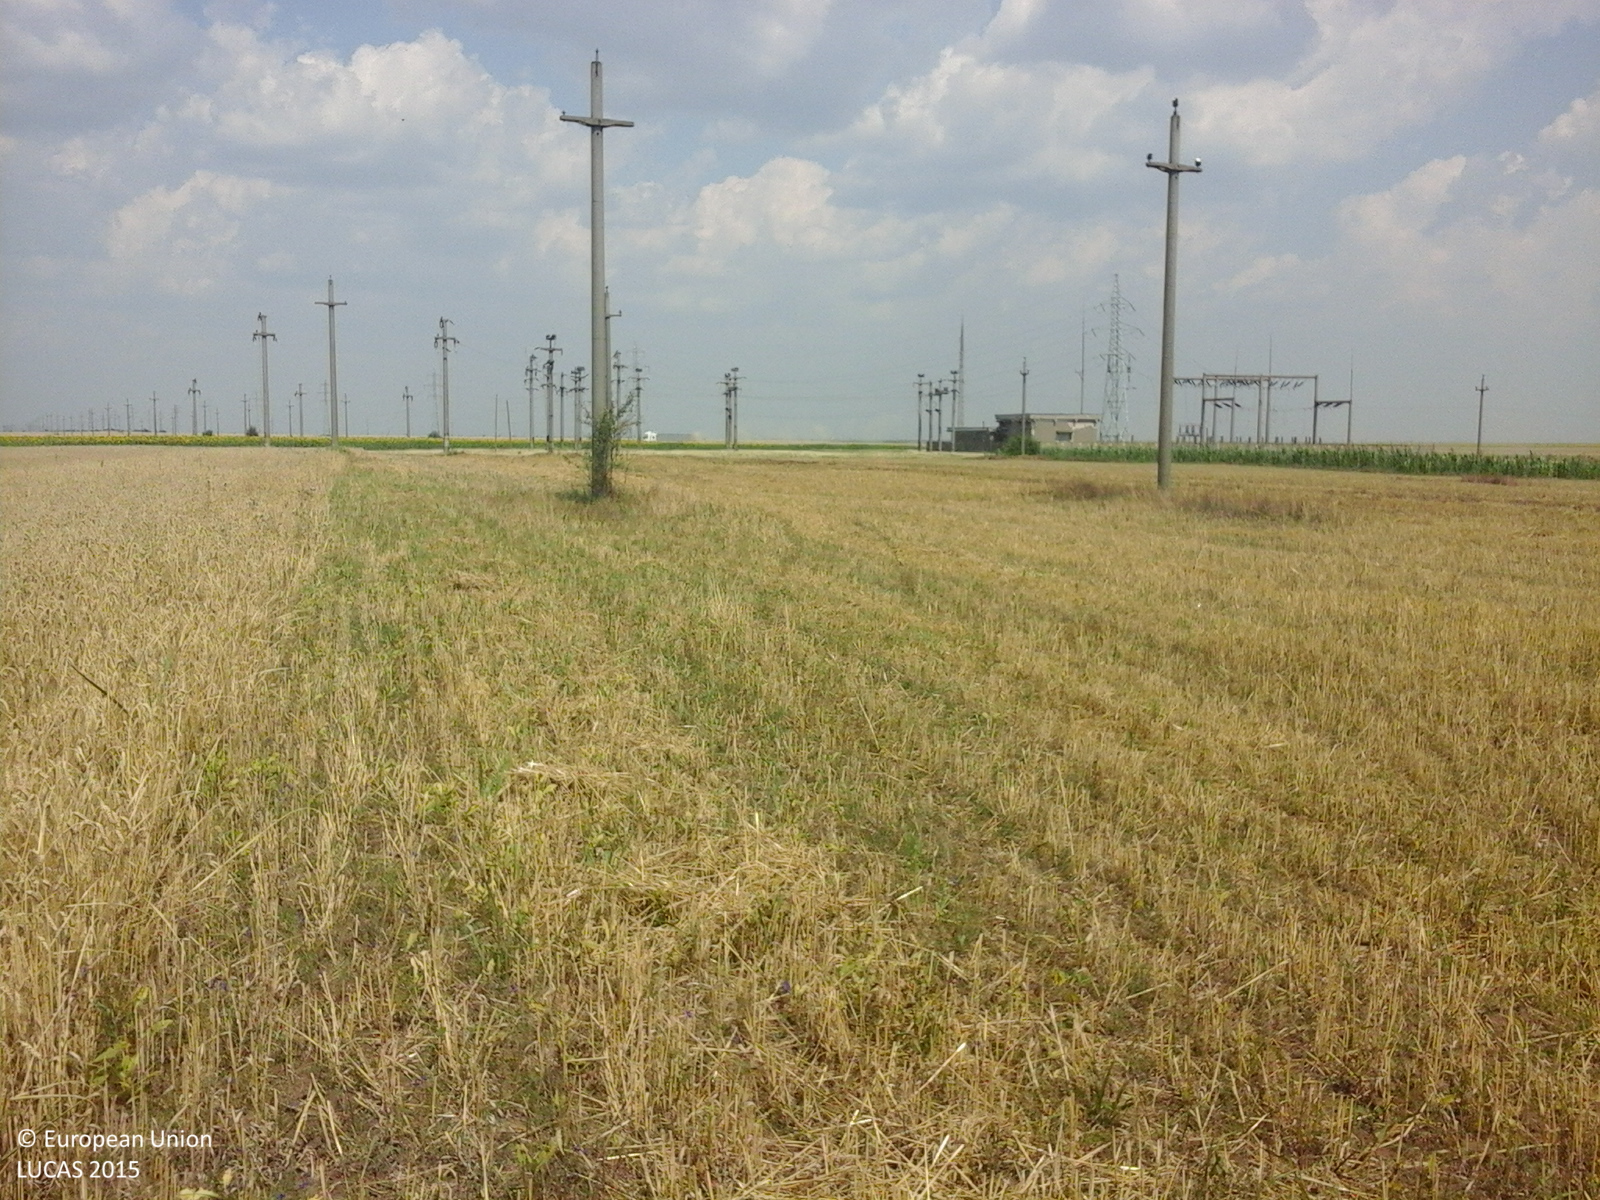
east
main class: Cropland
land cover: Durum wheat
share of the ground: > 75 %
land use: Agriculture (excluding fallow land and kitchen gardens)
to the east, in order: Durum wheat; Electric lines; Durum wheat; Tracks; Grassland without tree/shrub cover; Electric lines; Grassland without tree/shrub cover
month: July
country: RO
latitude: 43.8449
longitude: 24.8360
